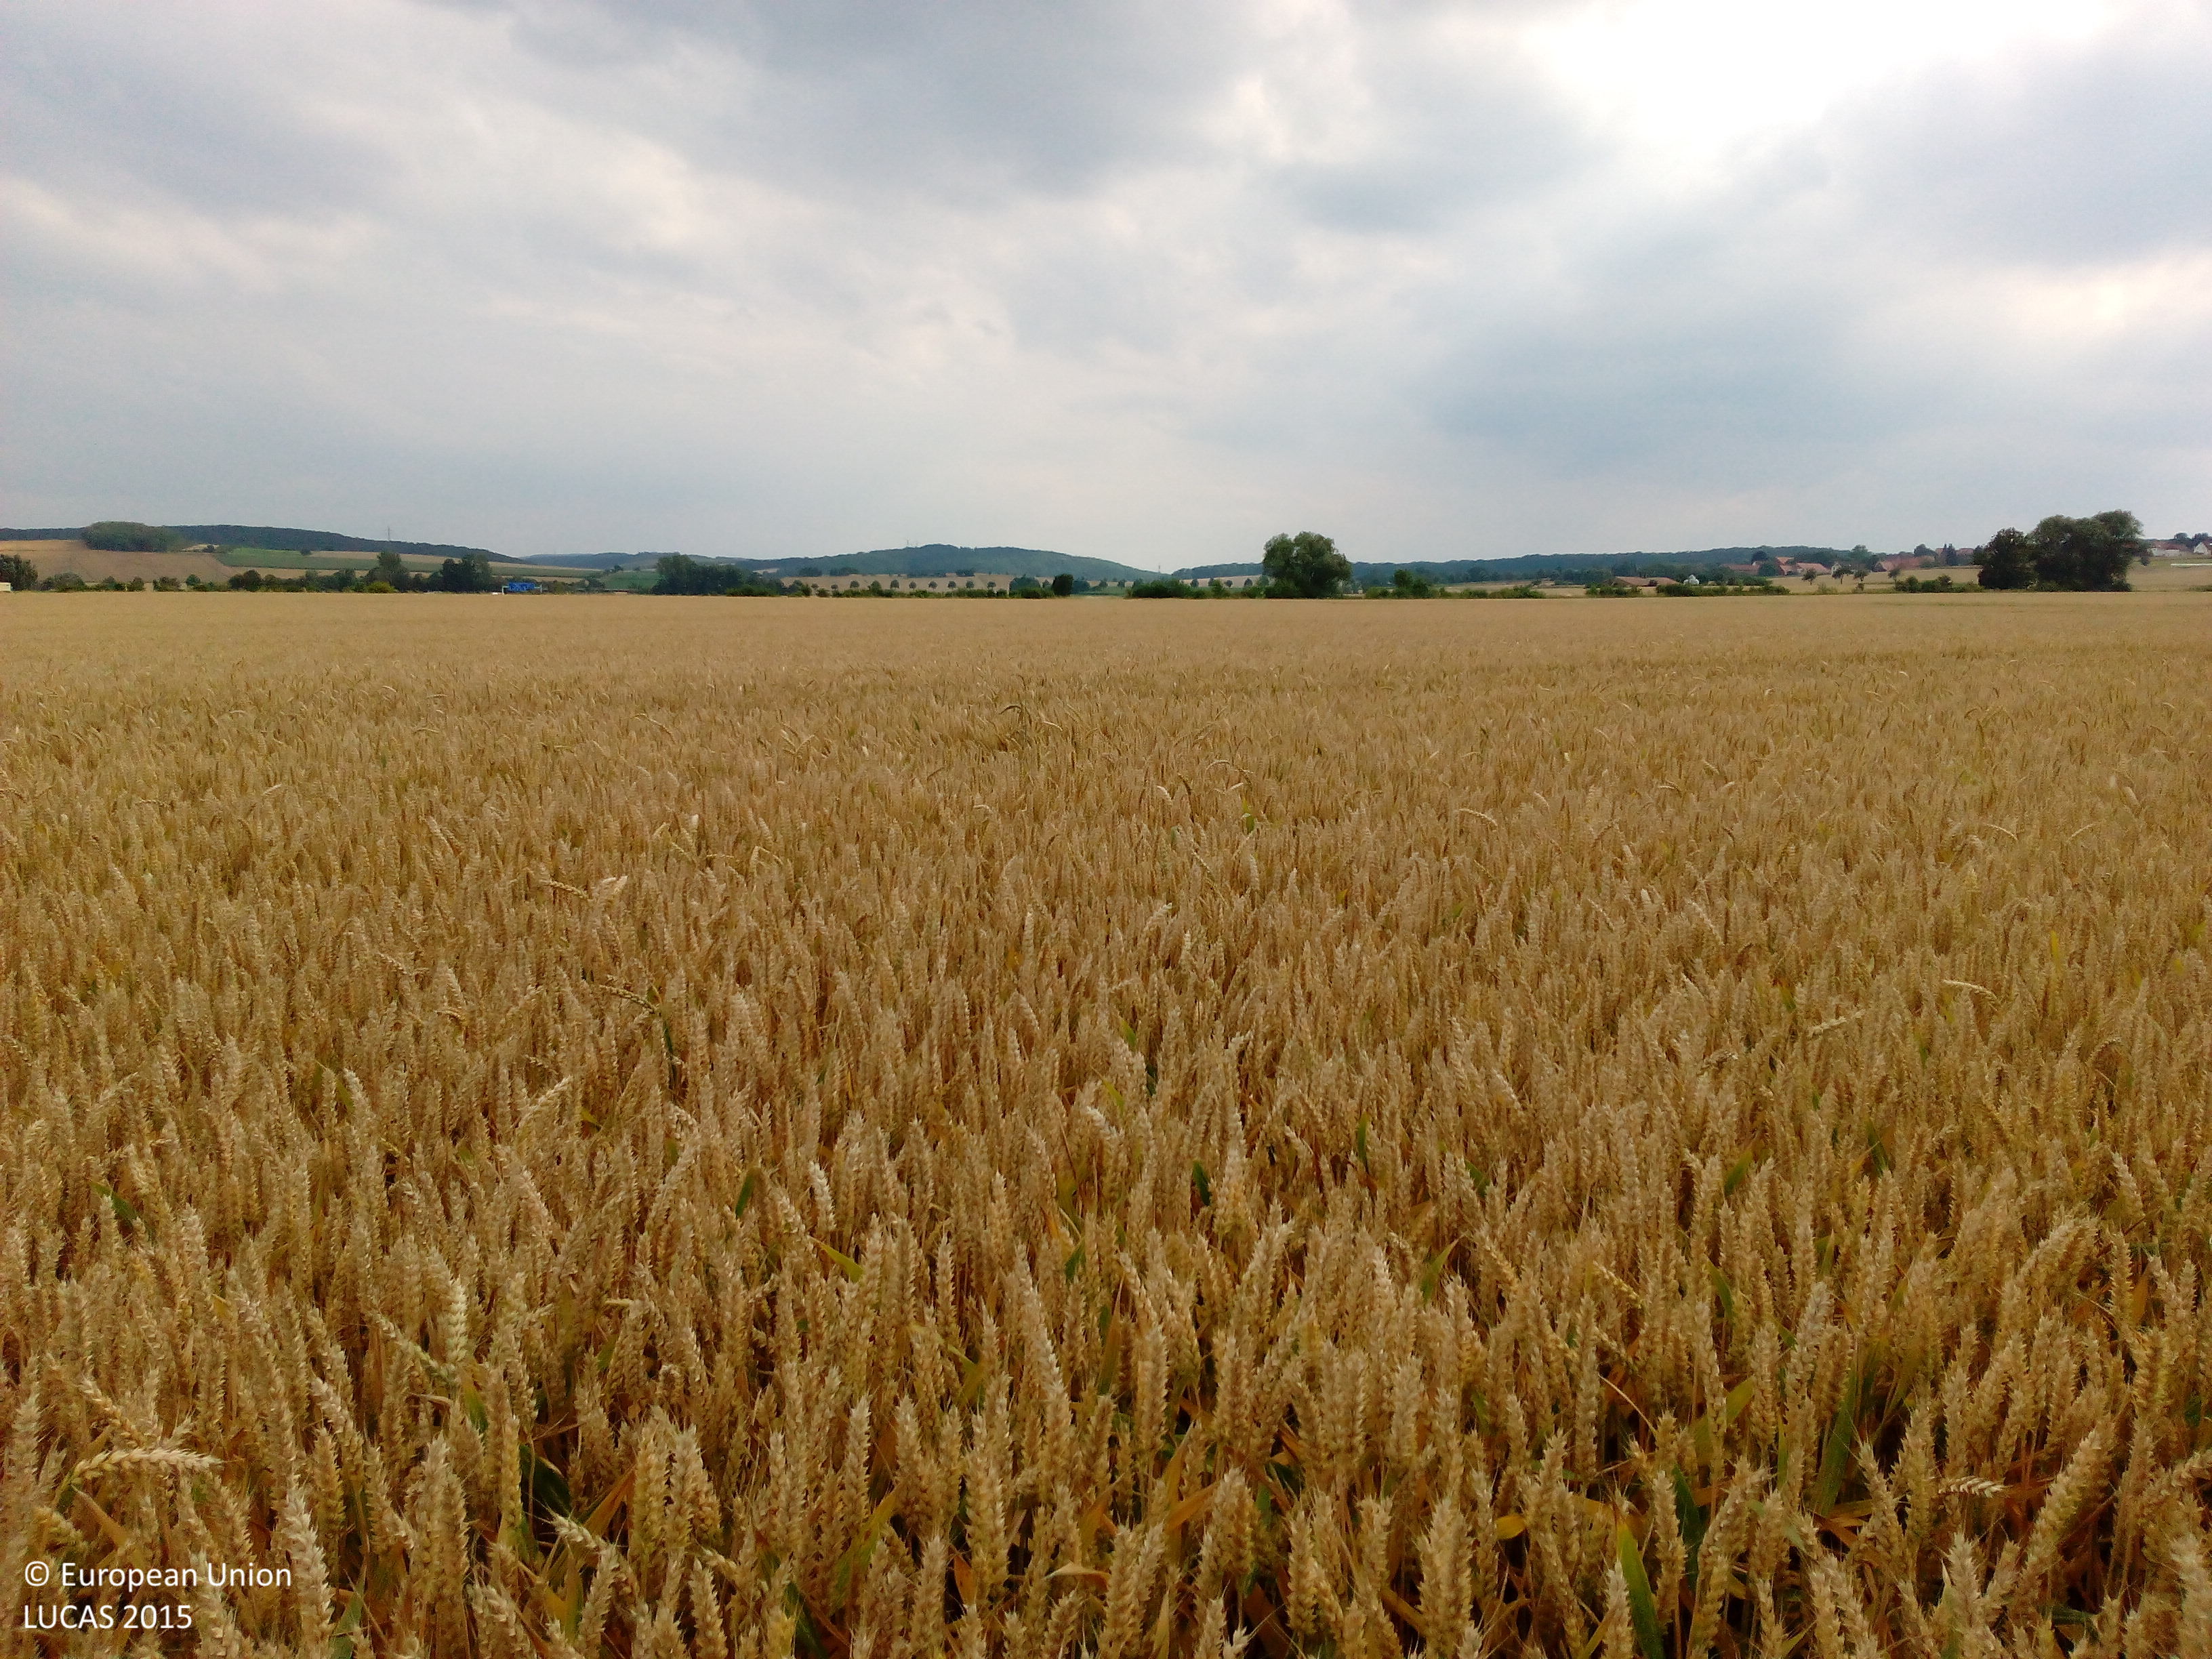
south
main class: Cropland
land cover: Common wheat
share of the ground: > 75 %
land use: Agriculture (excluding fallow land and kitchen gardens)
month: July
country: DE
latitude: 51.4786
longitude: 9.8705
